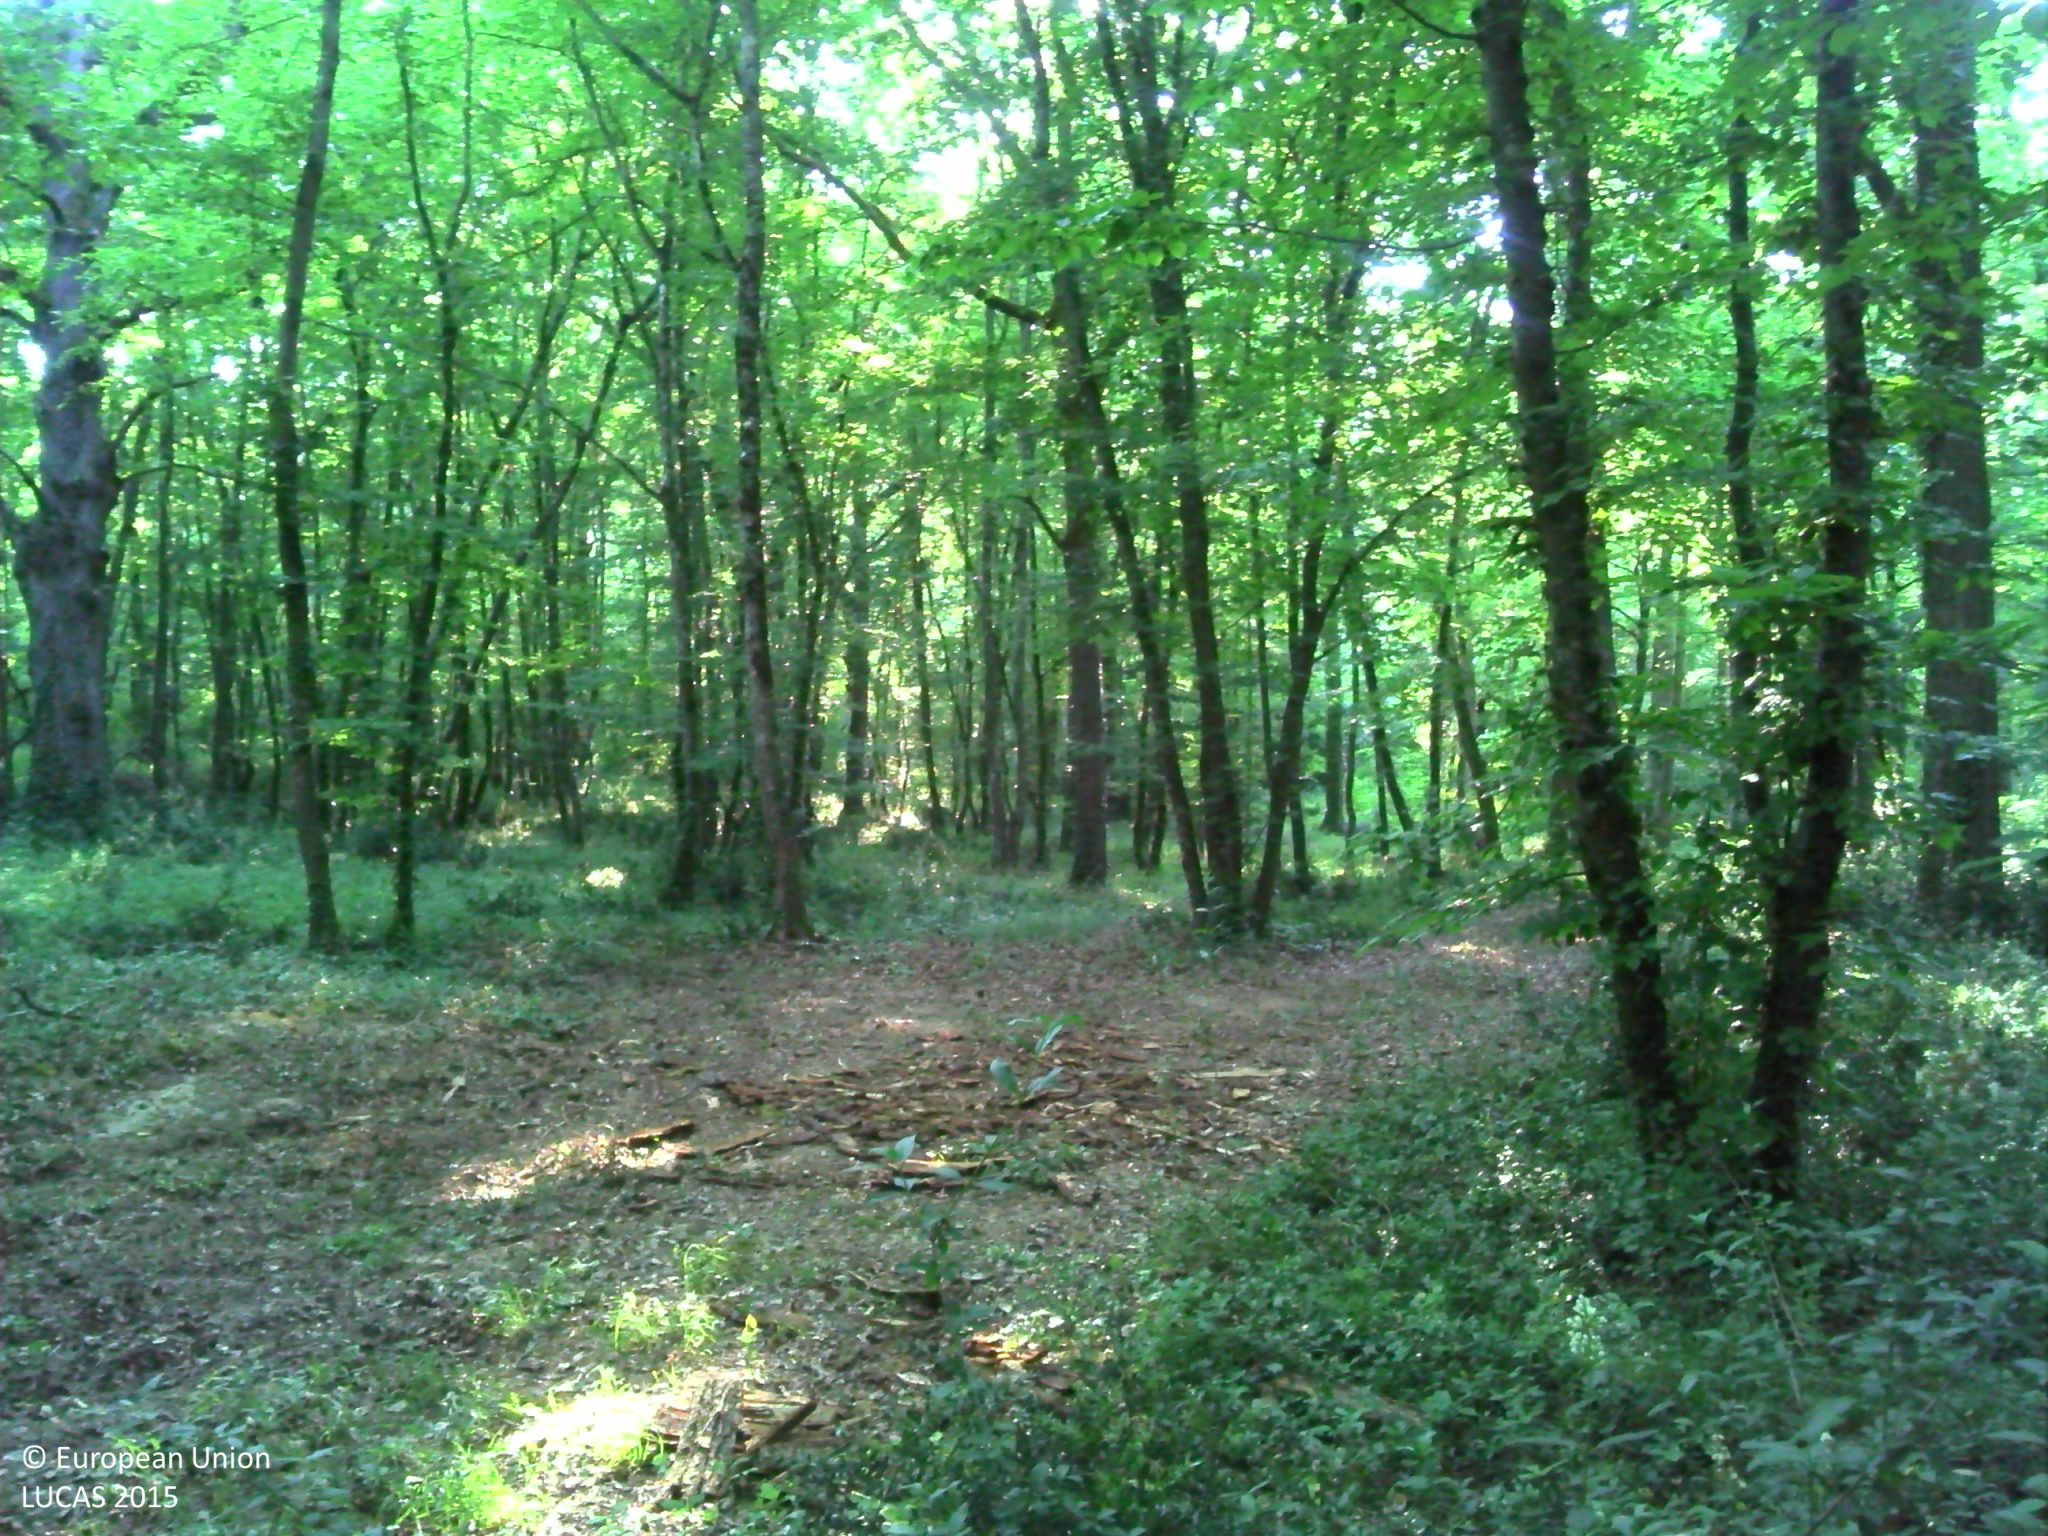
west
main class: Woodland
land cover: Broadleaved woodland
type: mesophytic deciduous forest
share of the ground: > 75 %
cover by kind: broadleaved forest trees 85 %, shrubs 10 %, herbaceous plants 5 %
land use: Forestry
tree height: > 5 m
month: June
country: FR
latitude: 43.6944
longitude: 0.6801
